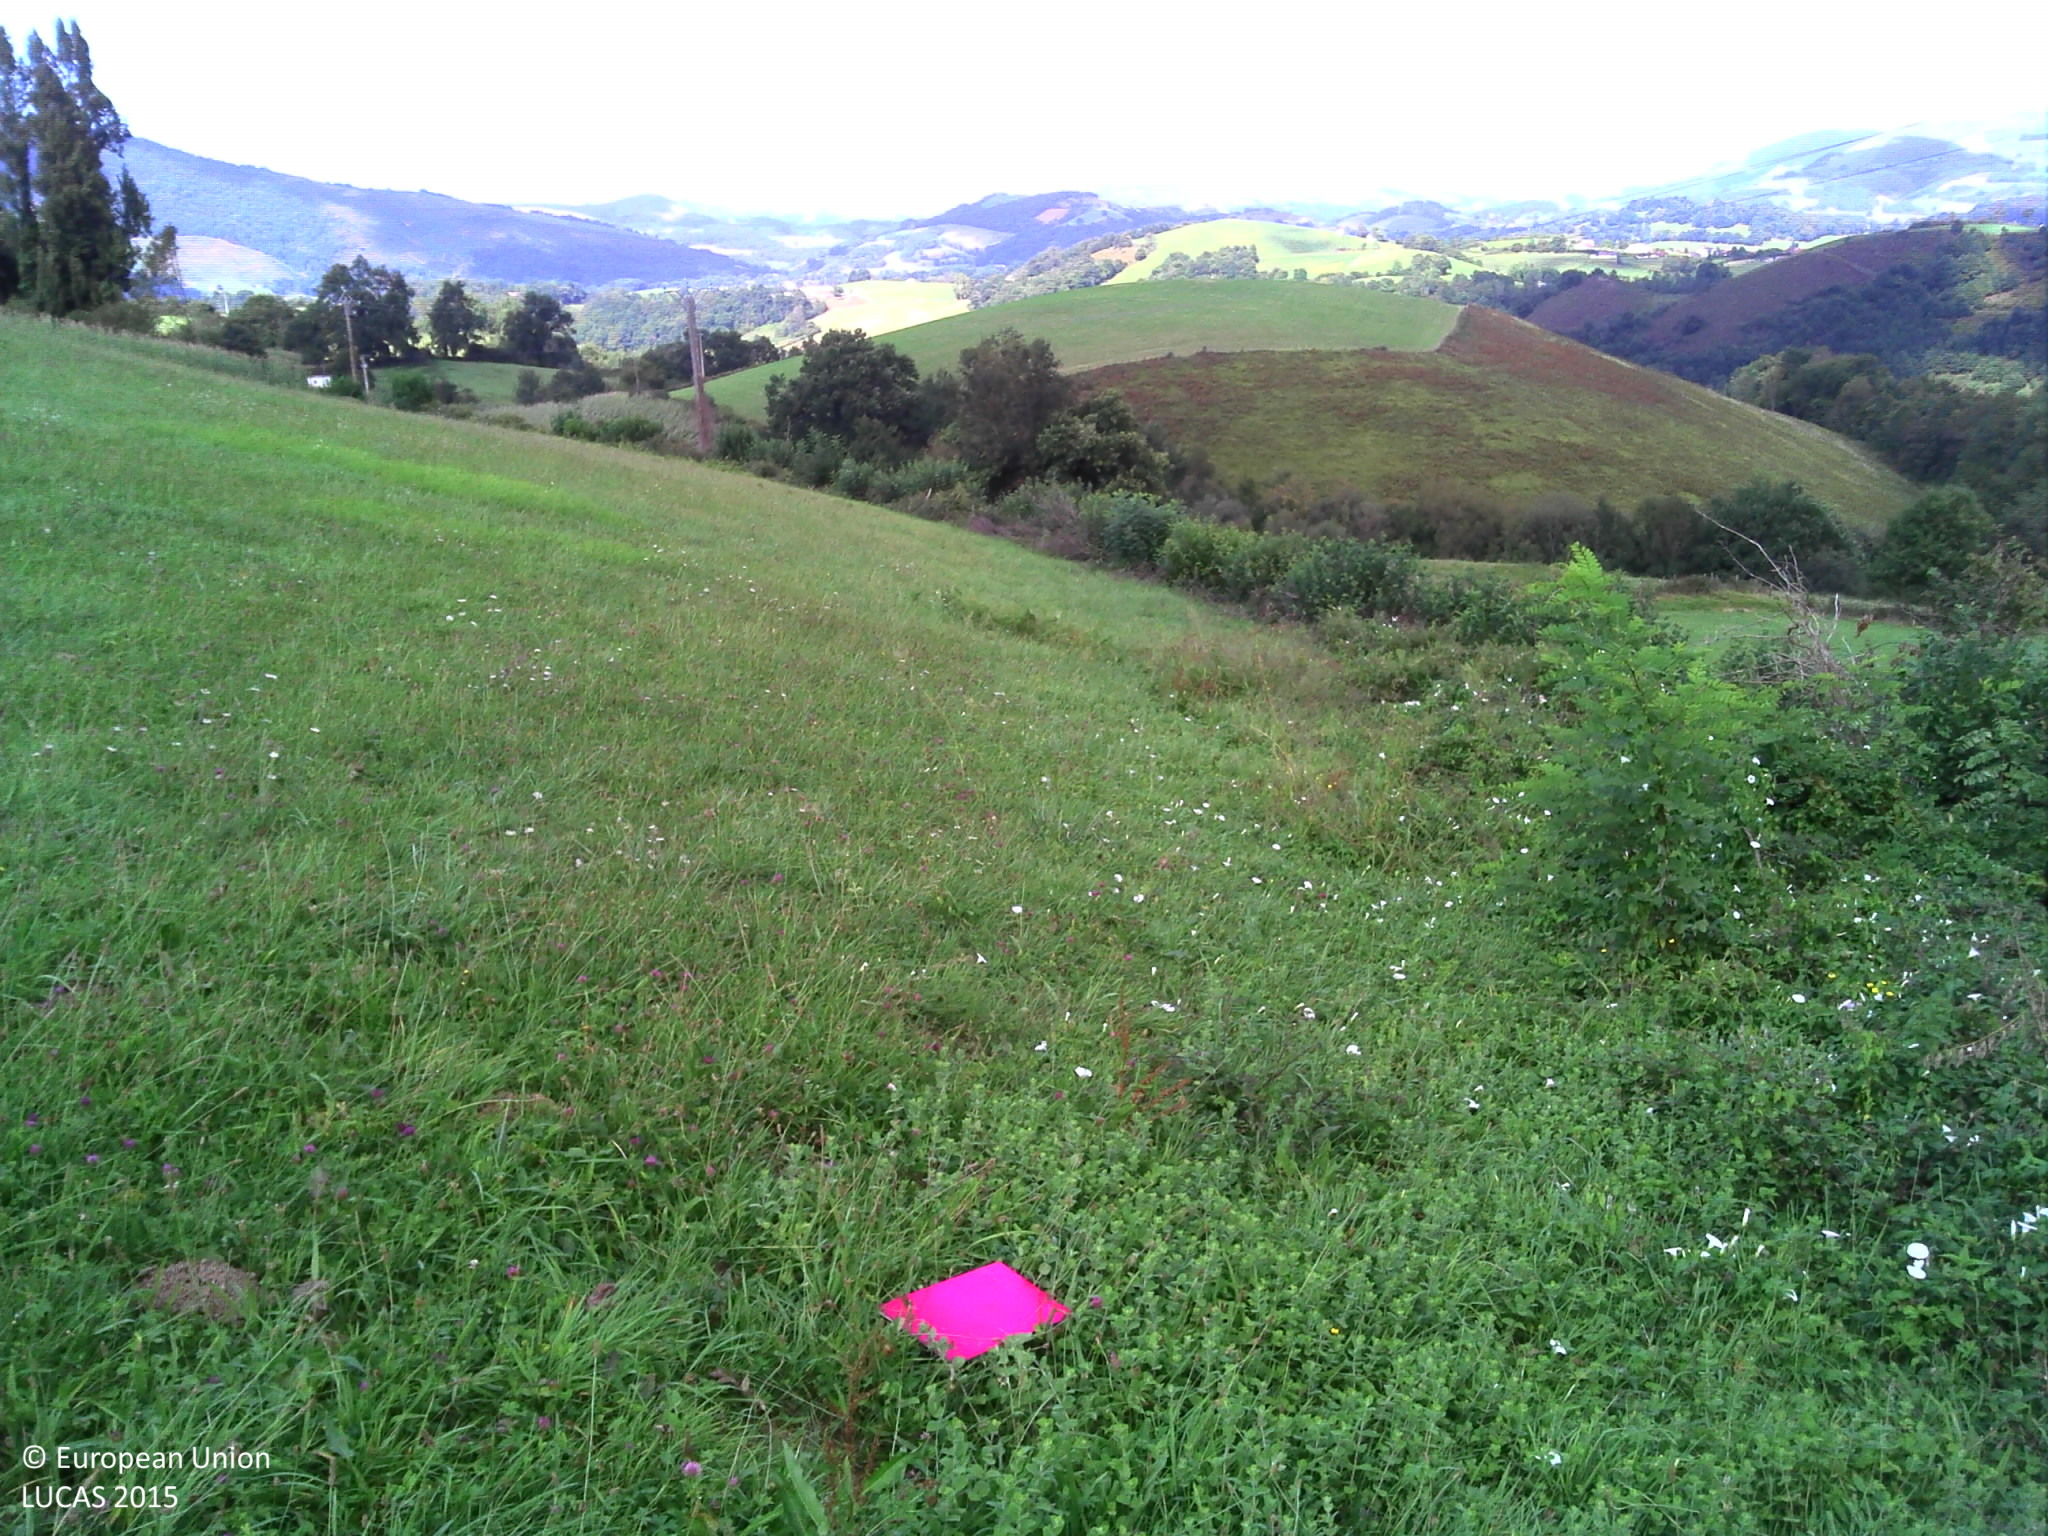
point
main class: Grassland
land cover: Grassland without tree/shrub cover
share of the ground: > 75 %
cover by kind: herbaceous plants 100 %
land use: Agriculture (excluding fallow land and kitchen gardens)
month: September
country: FR
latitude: 43.1375
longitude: -1.2378
